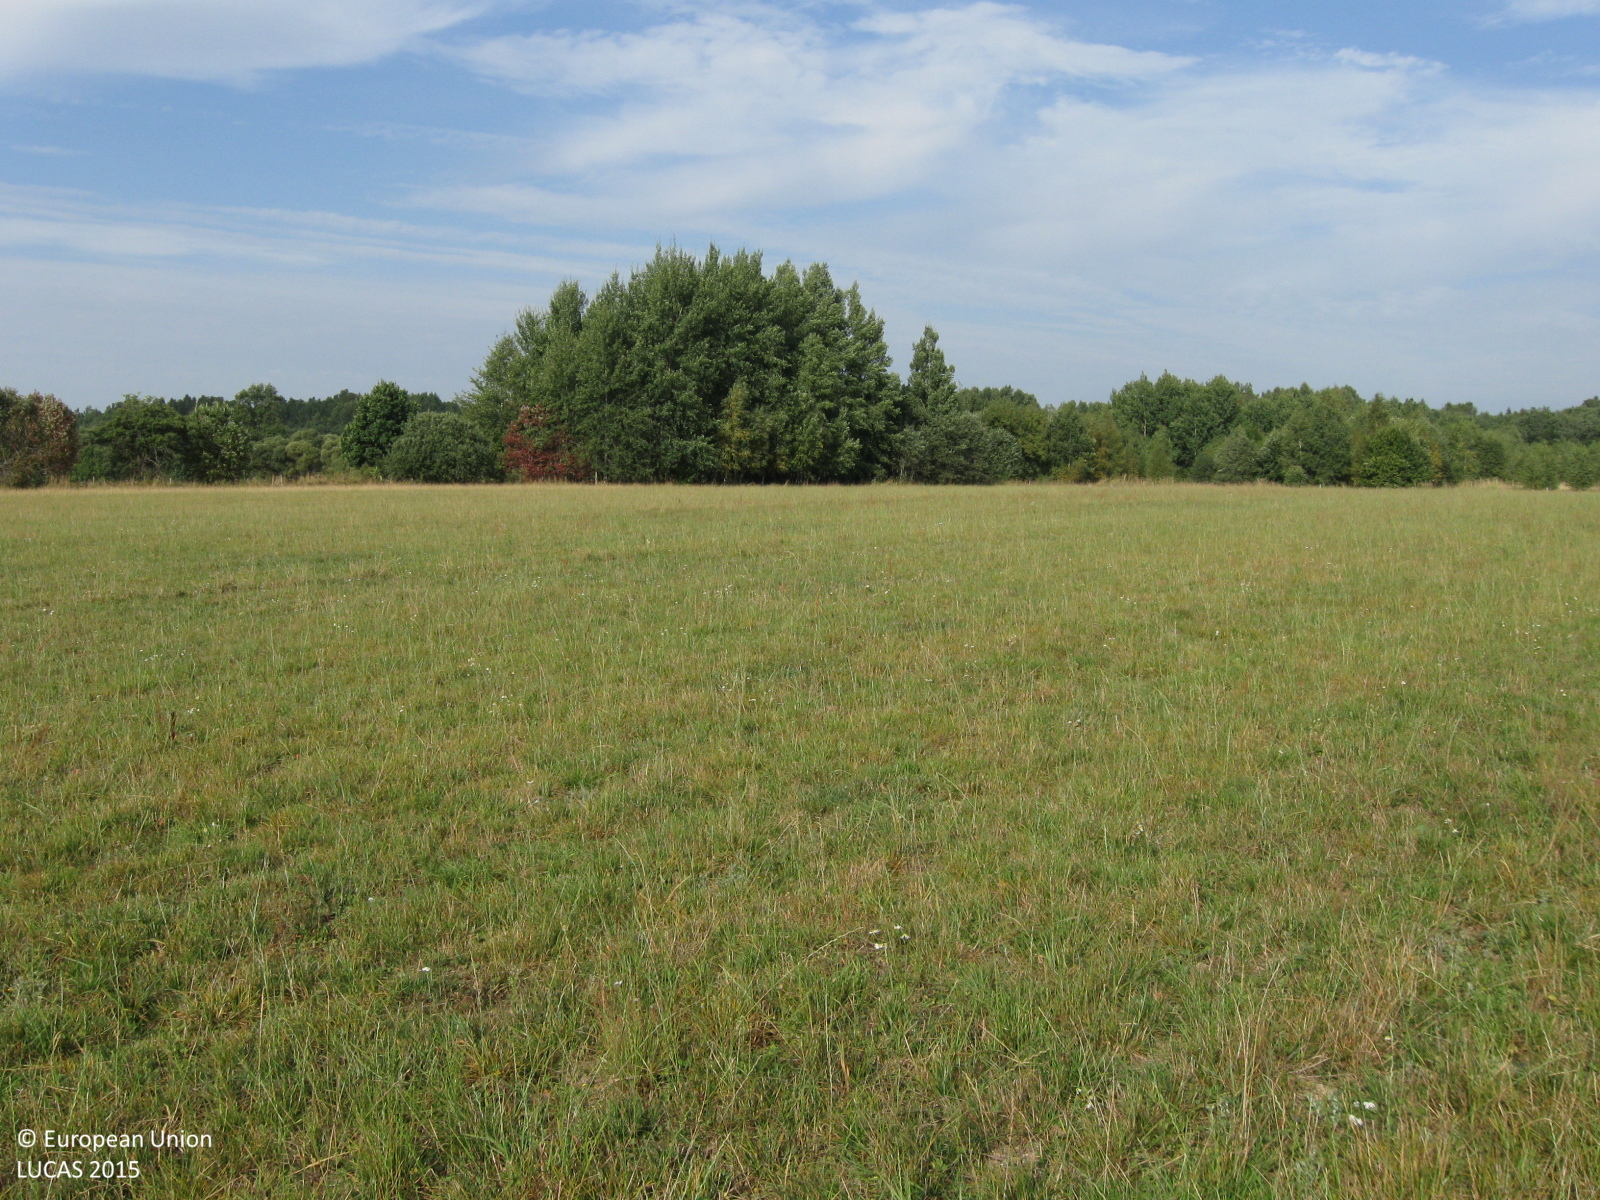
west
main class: Grassland
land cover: Grassland without tree/shrub cover
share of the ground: > 75 %
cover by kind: herbaceous plants 100 %
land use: Agriculture (excluding fallow land and kitchen gardens)
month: August
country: LT
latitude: 55.4400
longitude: 22.9192
